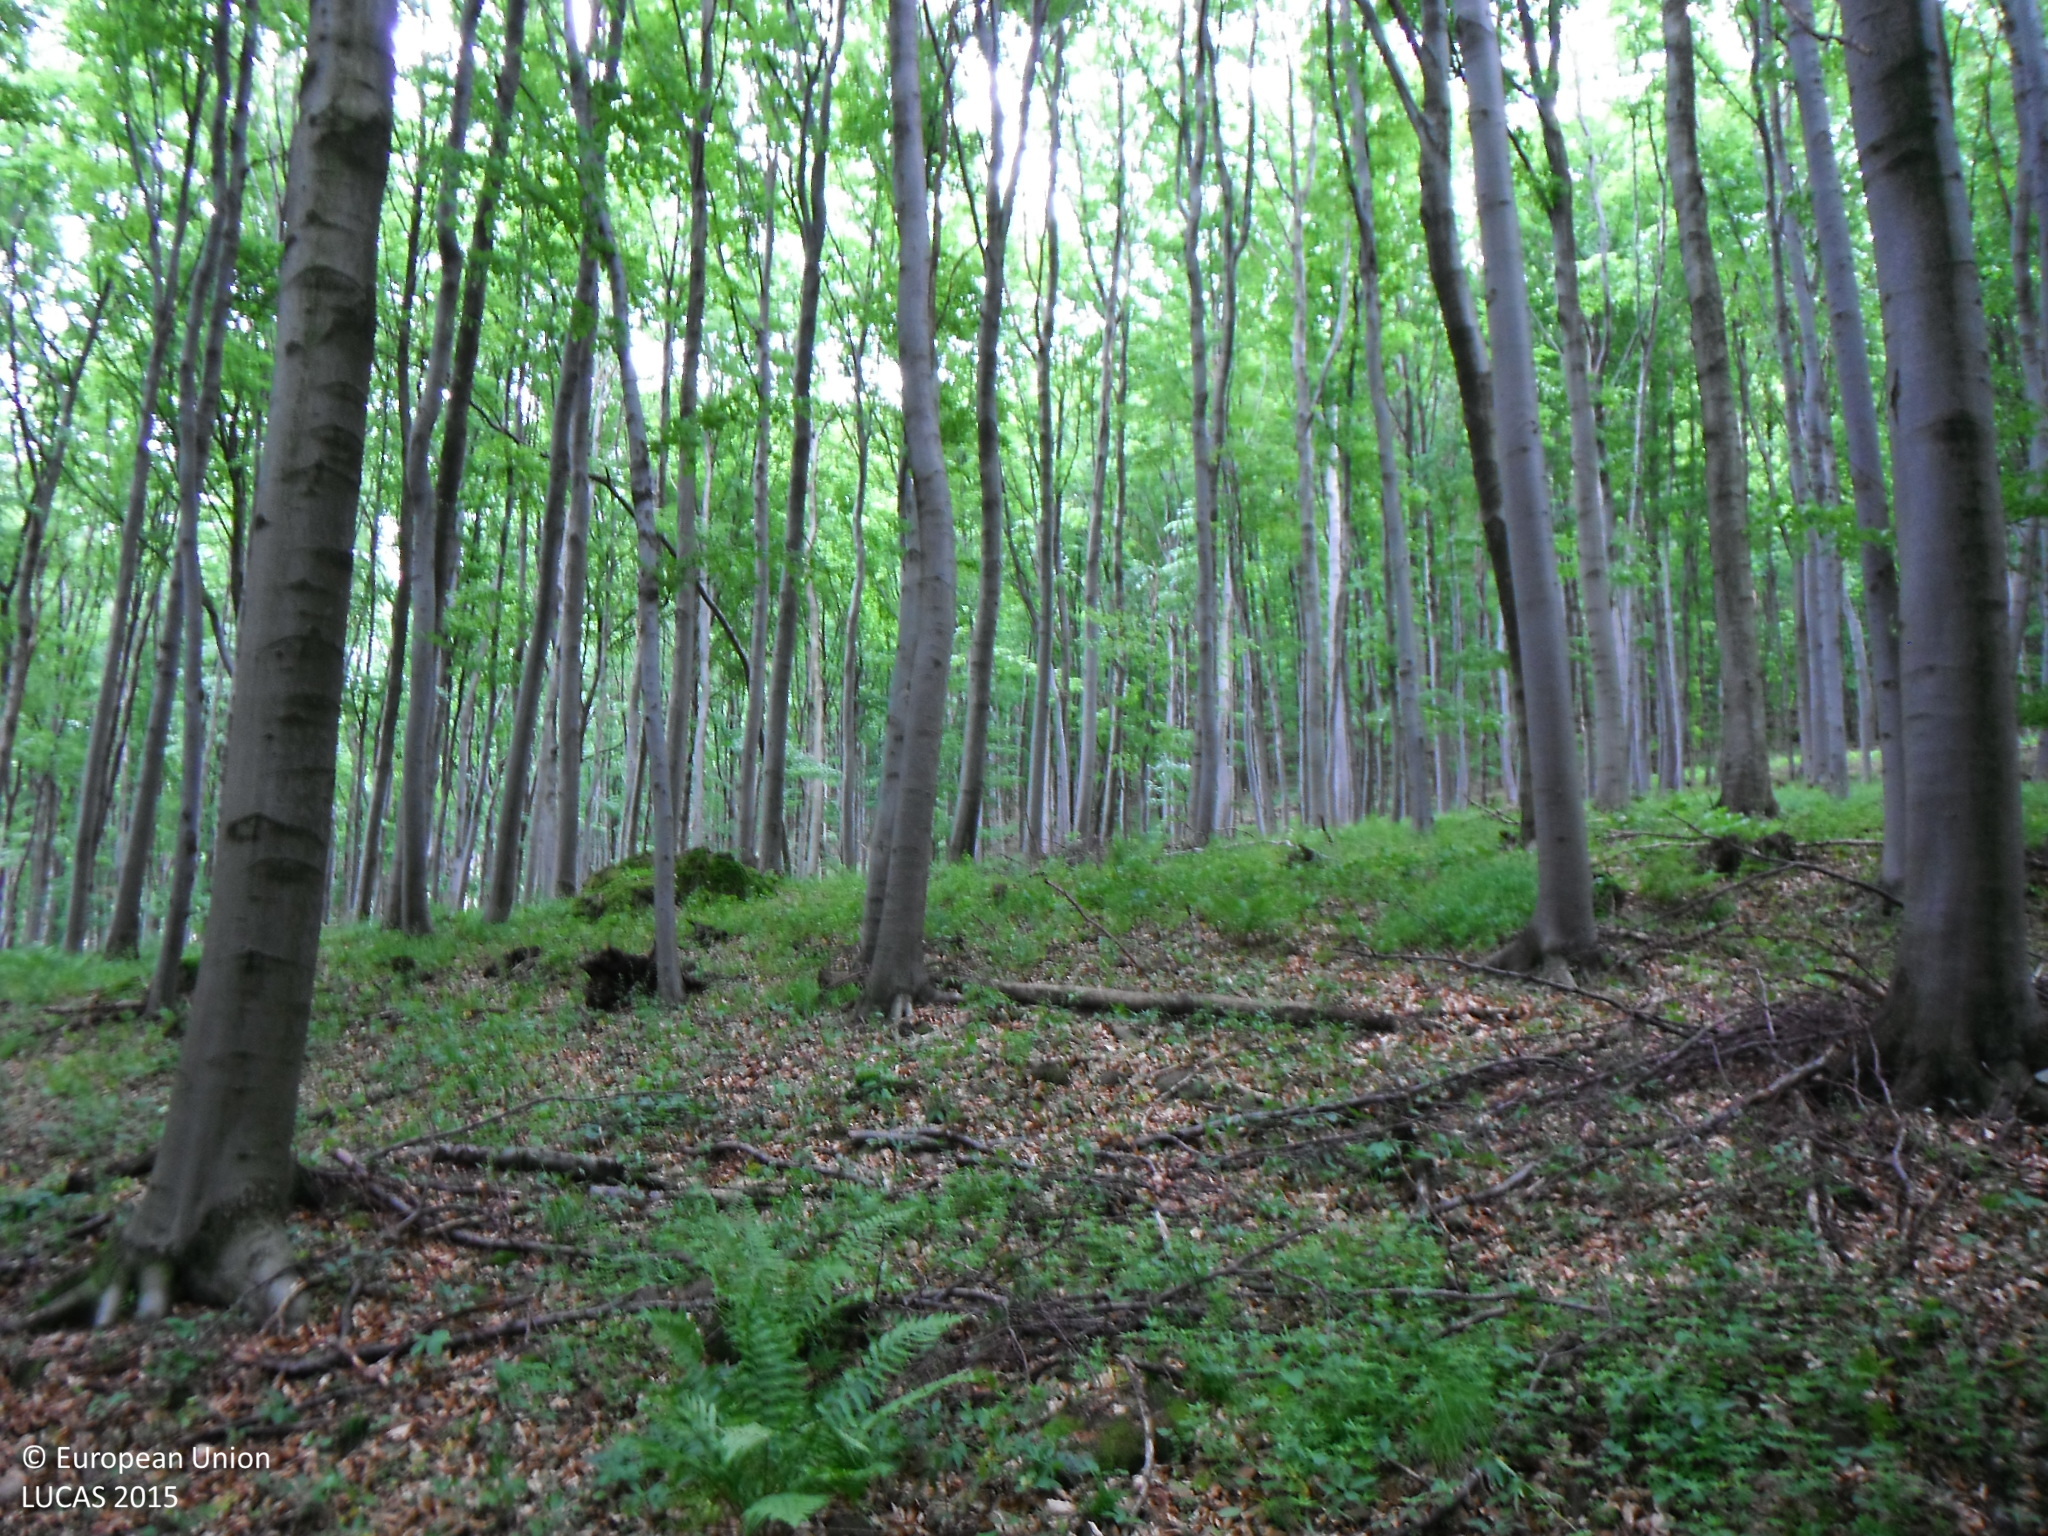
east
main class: Woodland
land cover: Broadleaved woodland
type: beech forest
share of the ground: > 75 %
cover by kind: broadleaved forest trees 100 %
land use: Forestry
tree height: > 5 m
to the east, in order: Broadleaved woodland
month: May
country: SK
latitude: 48.9801
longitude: 21.3459
